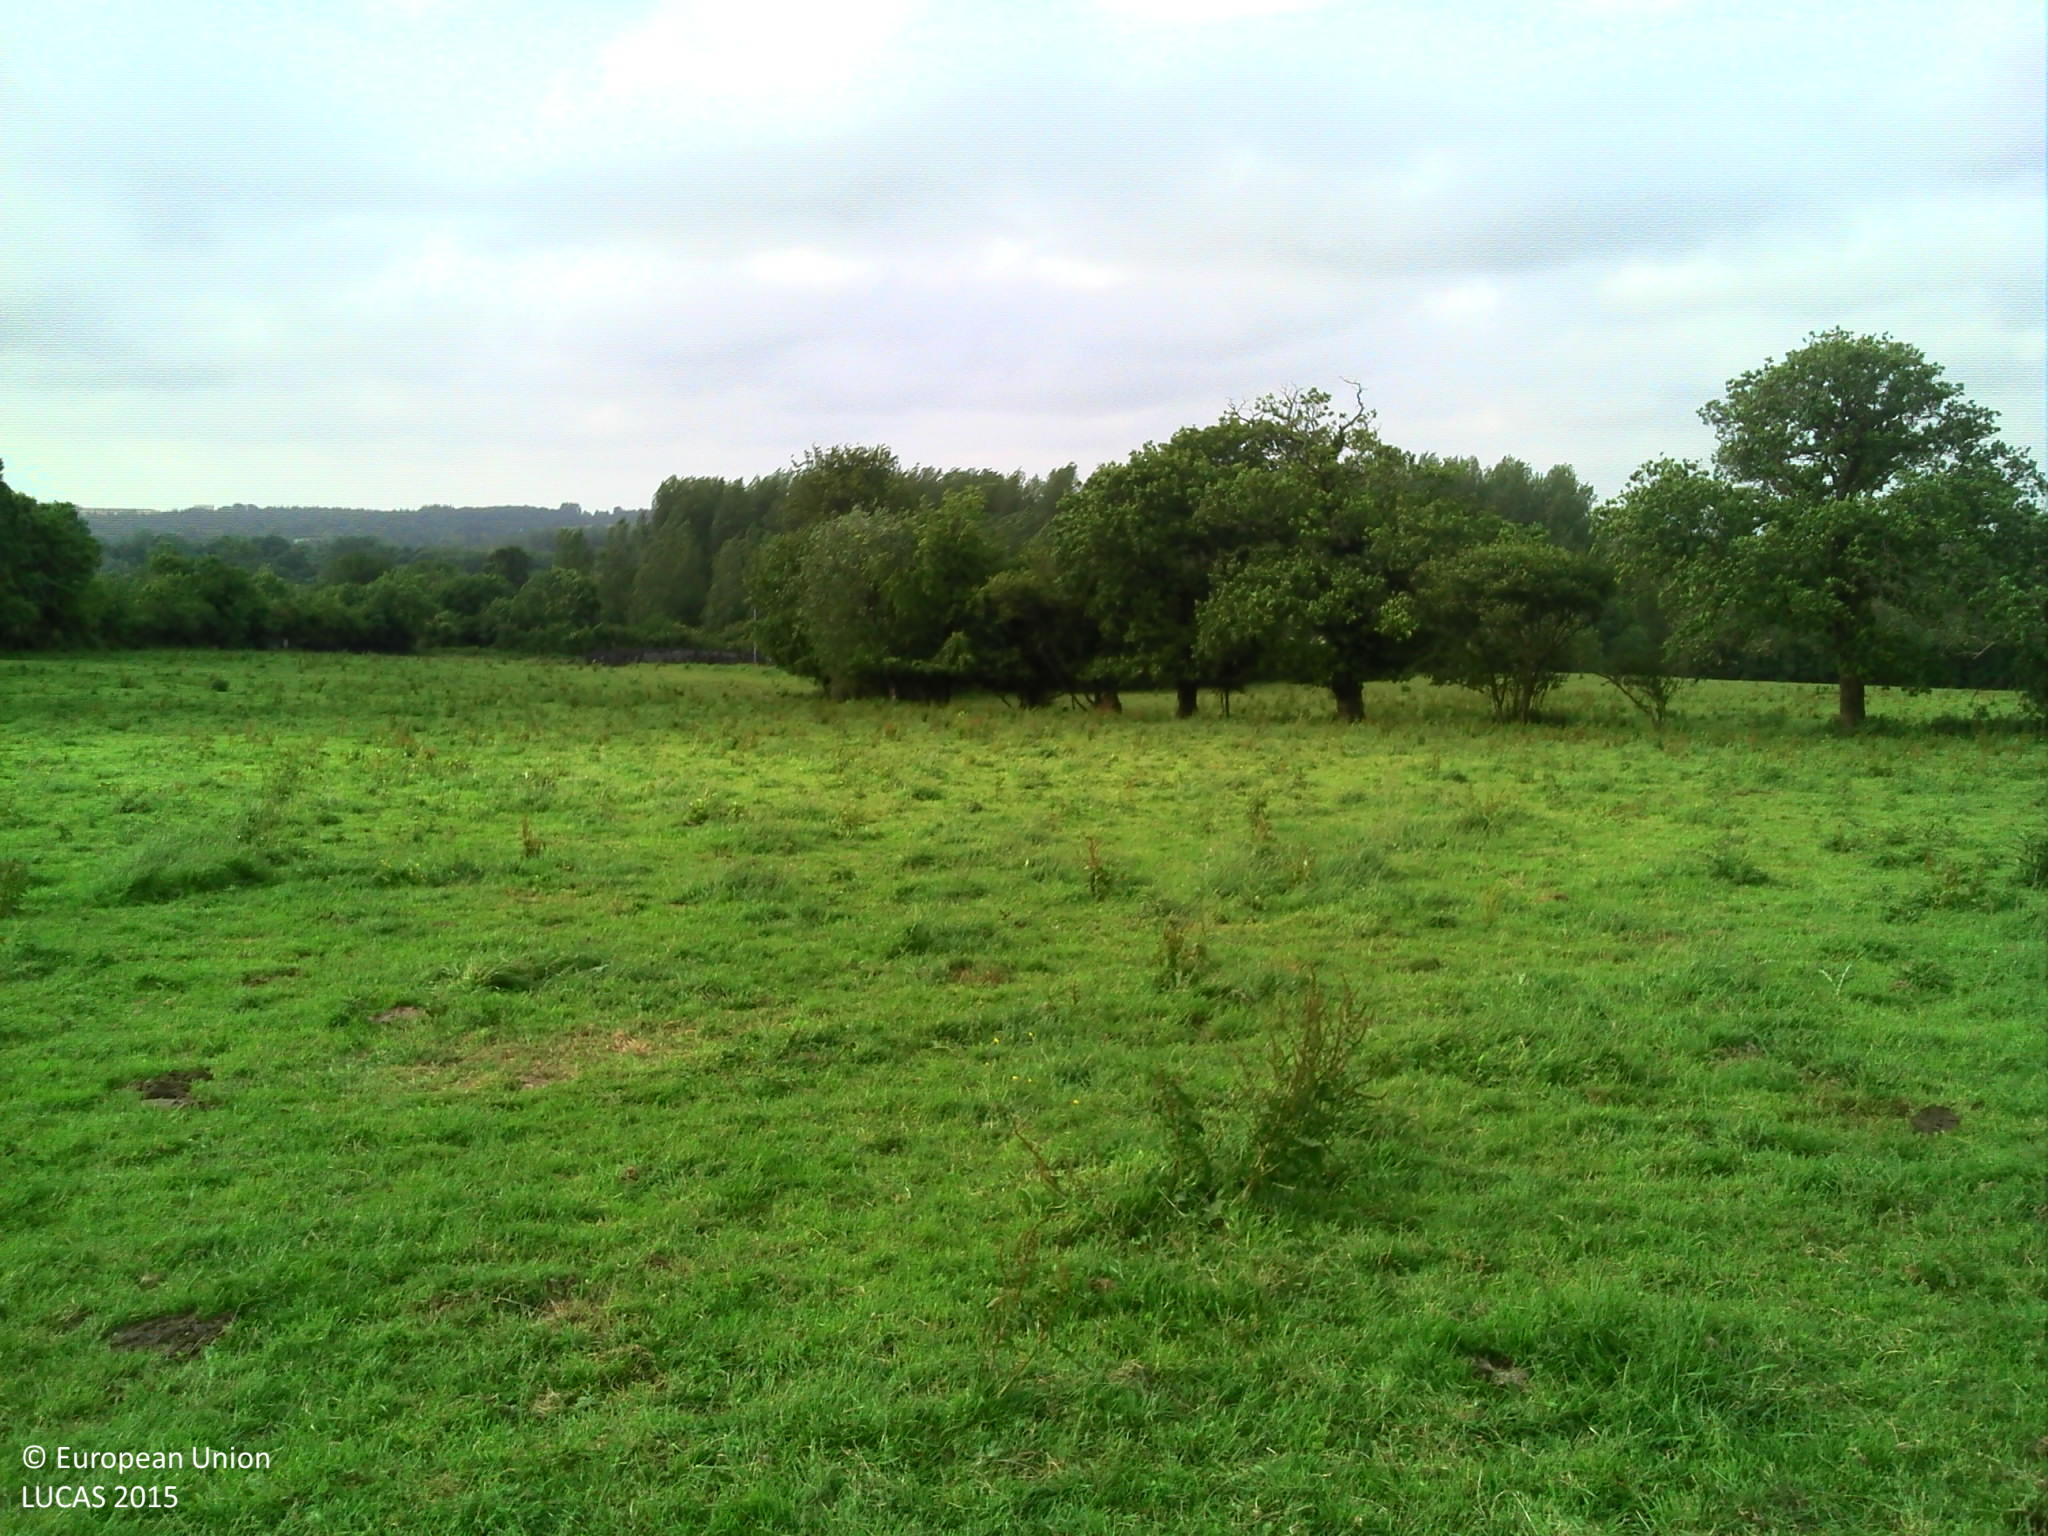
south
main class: Grassland
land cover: Grassland without tree/shrub cover
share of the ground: > 75 %
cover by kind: herbaceous plants 95 %, shrubs 5 %
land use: Agriculture (excluding fallow land and kitchen gardens)
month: June
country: FR
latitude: 49.5356
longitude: -1.4207
